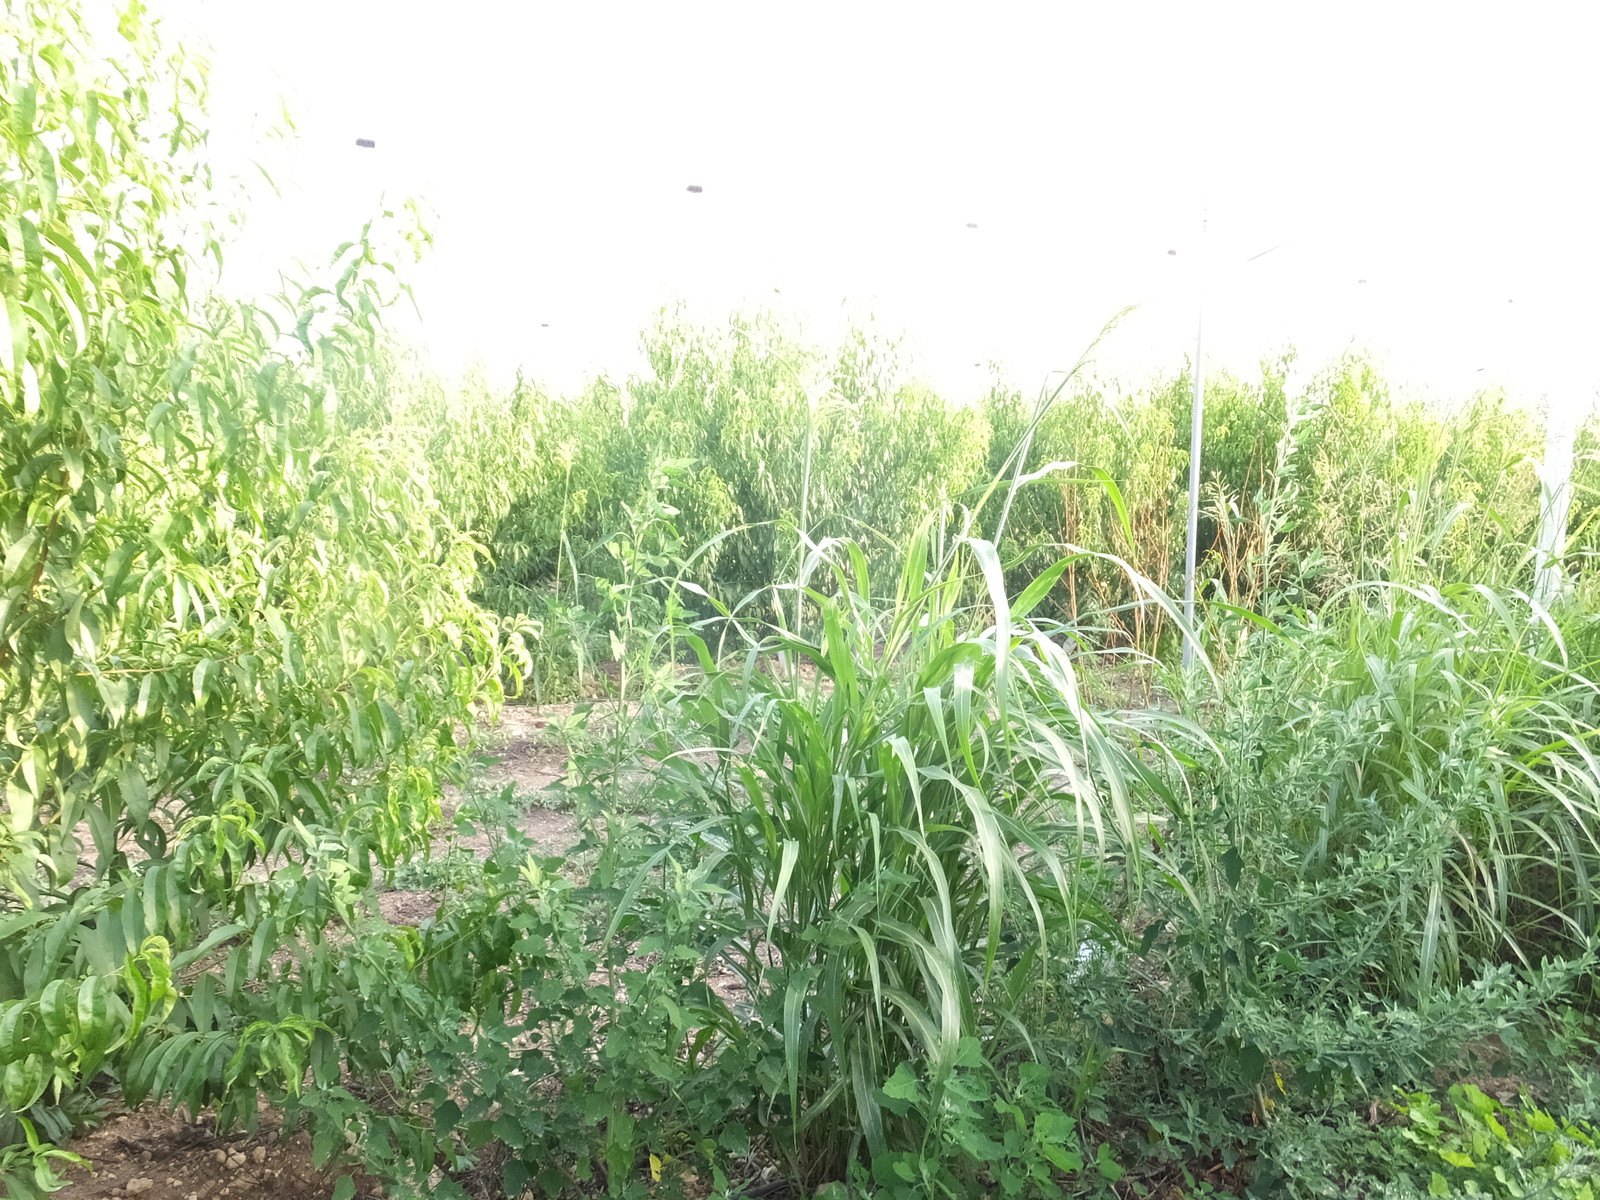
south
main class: Cropland
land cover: Other fruit trees and berries
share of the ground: > 75 %
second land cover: Spontaneously vegetated surfaces
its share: 10 - 25 %
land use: Agriculture (excluding fallow land and kitchen gardens)
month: August
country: ES
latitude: 41.5995
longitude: 0.4246
